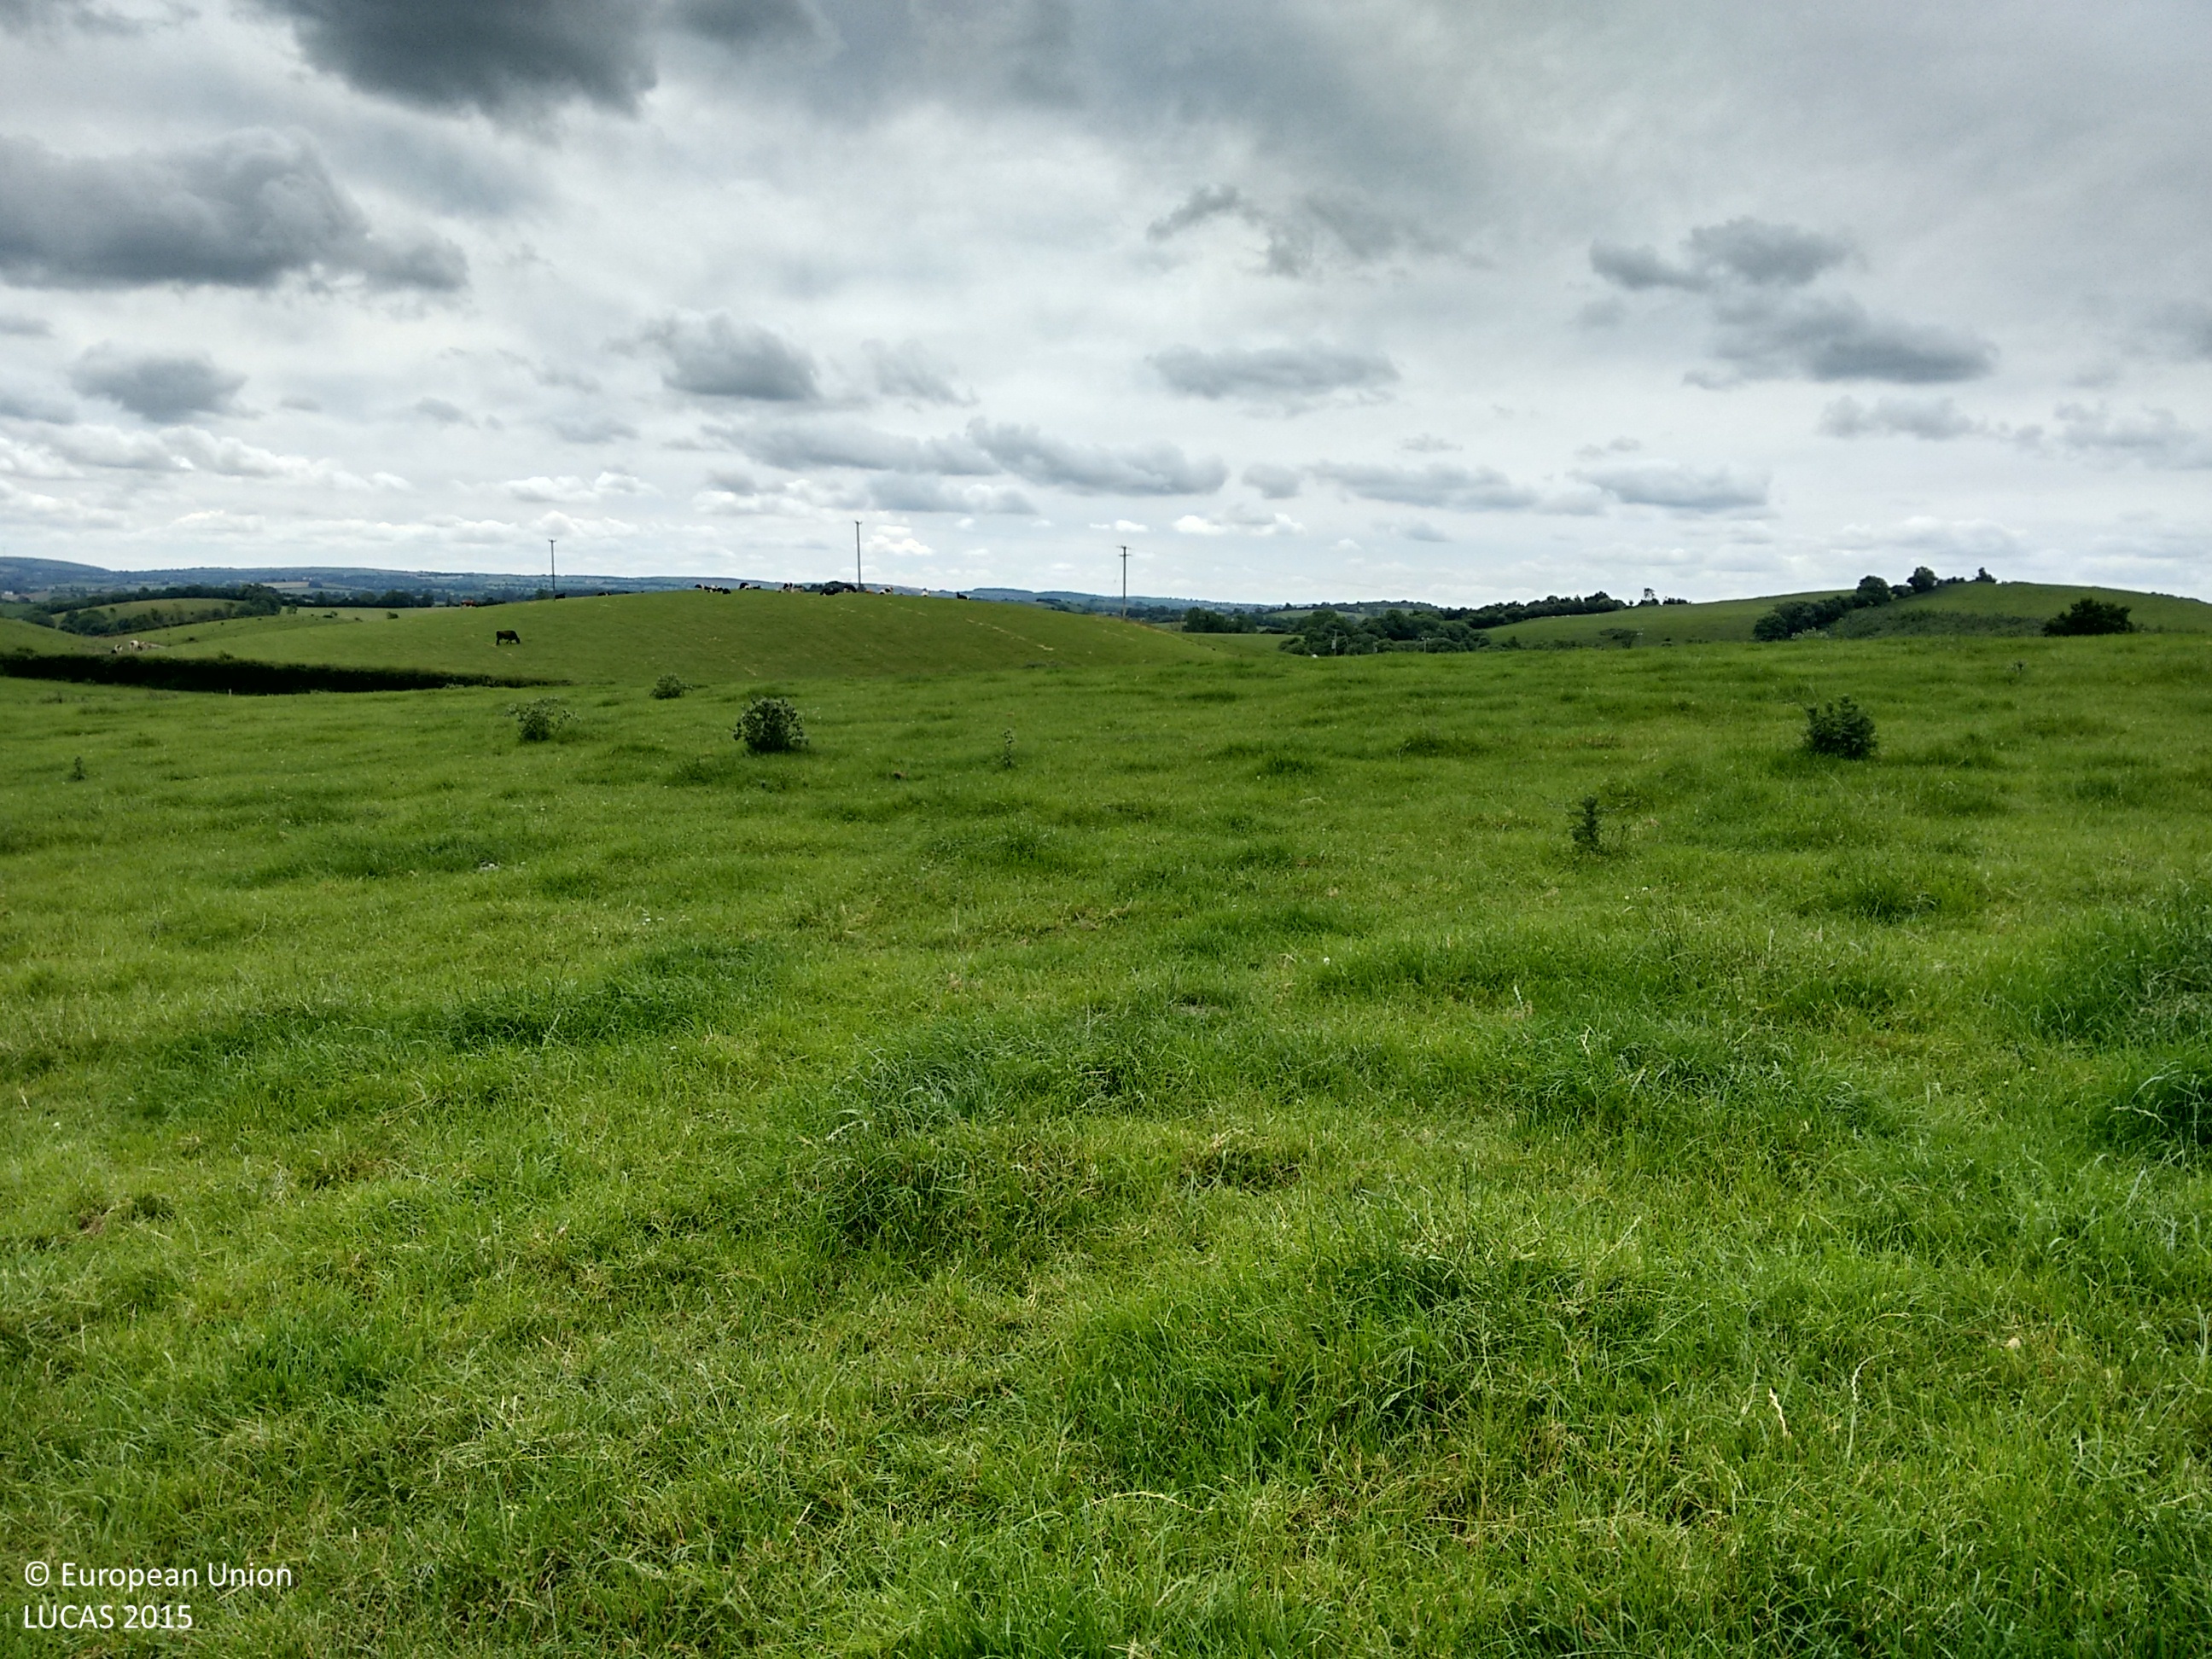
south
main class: Grassland
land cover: Grassland without tree/shrub cover
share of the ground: > 75 %
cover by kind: herbaceous plants 100 %
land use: Agriculture (excluding fallow land and kitchen gardens)
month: July
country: IE
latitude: 53.8719
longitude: -6.6629
